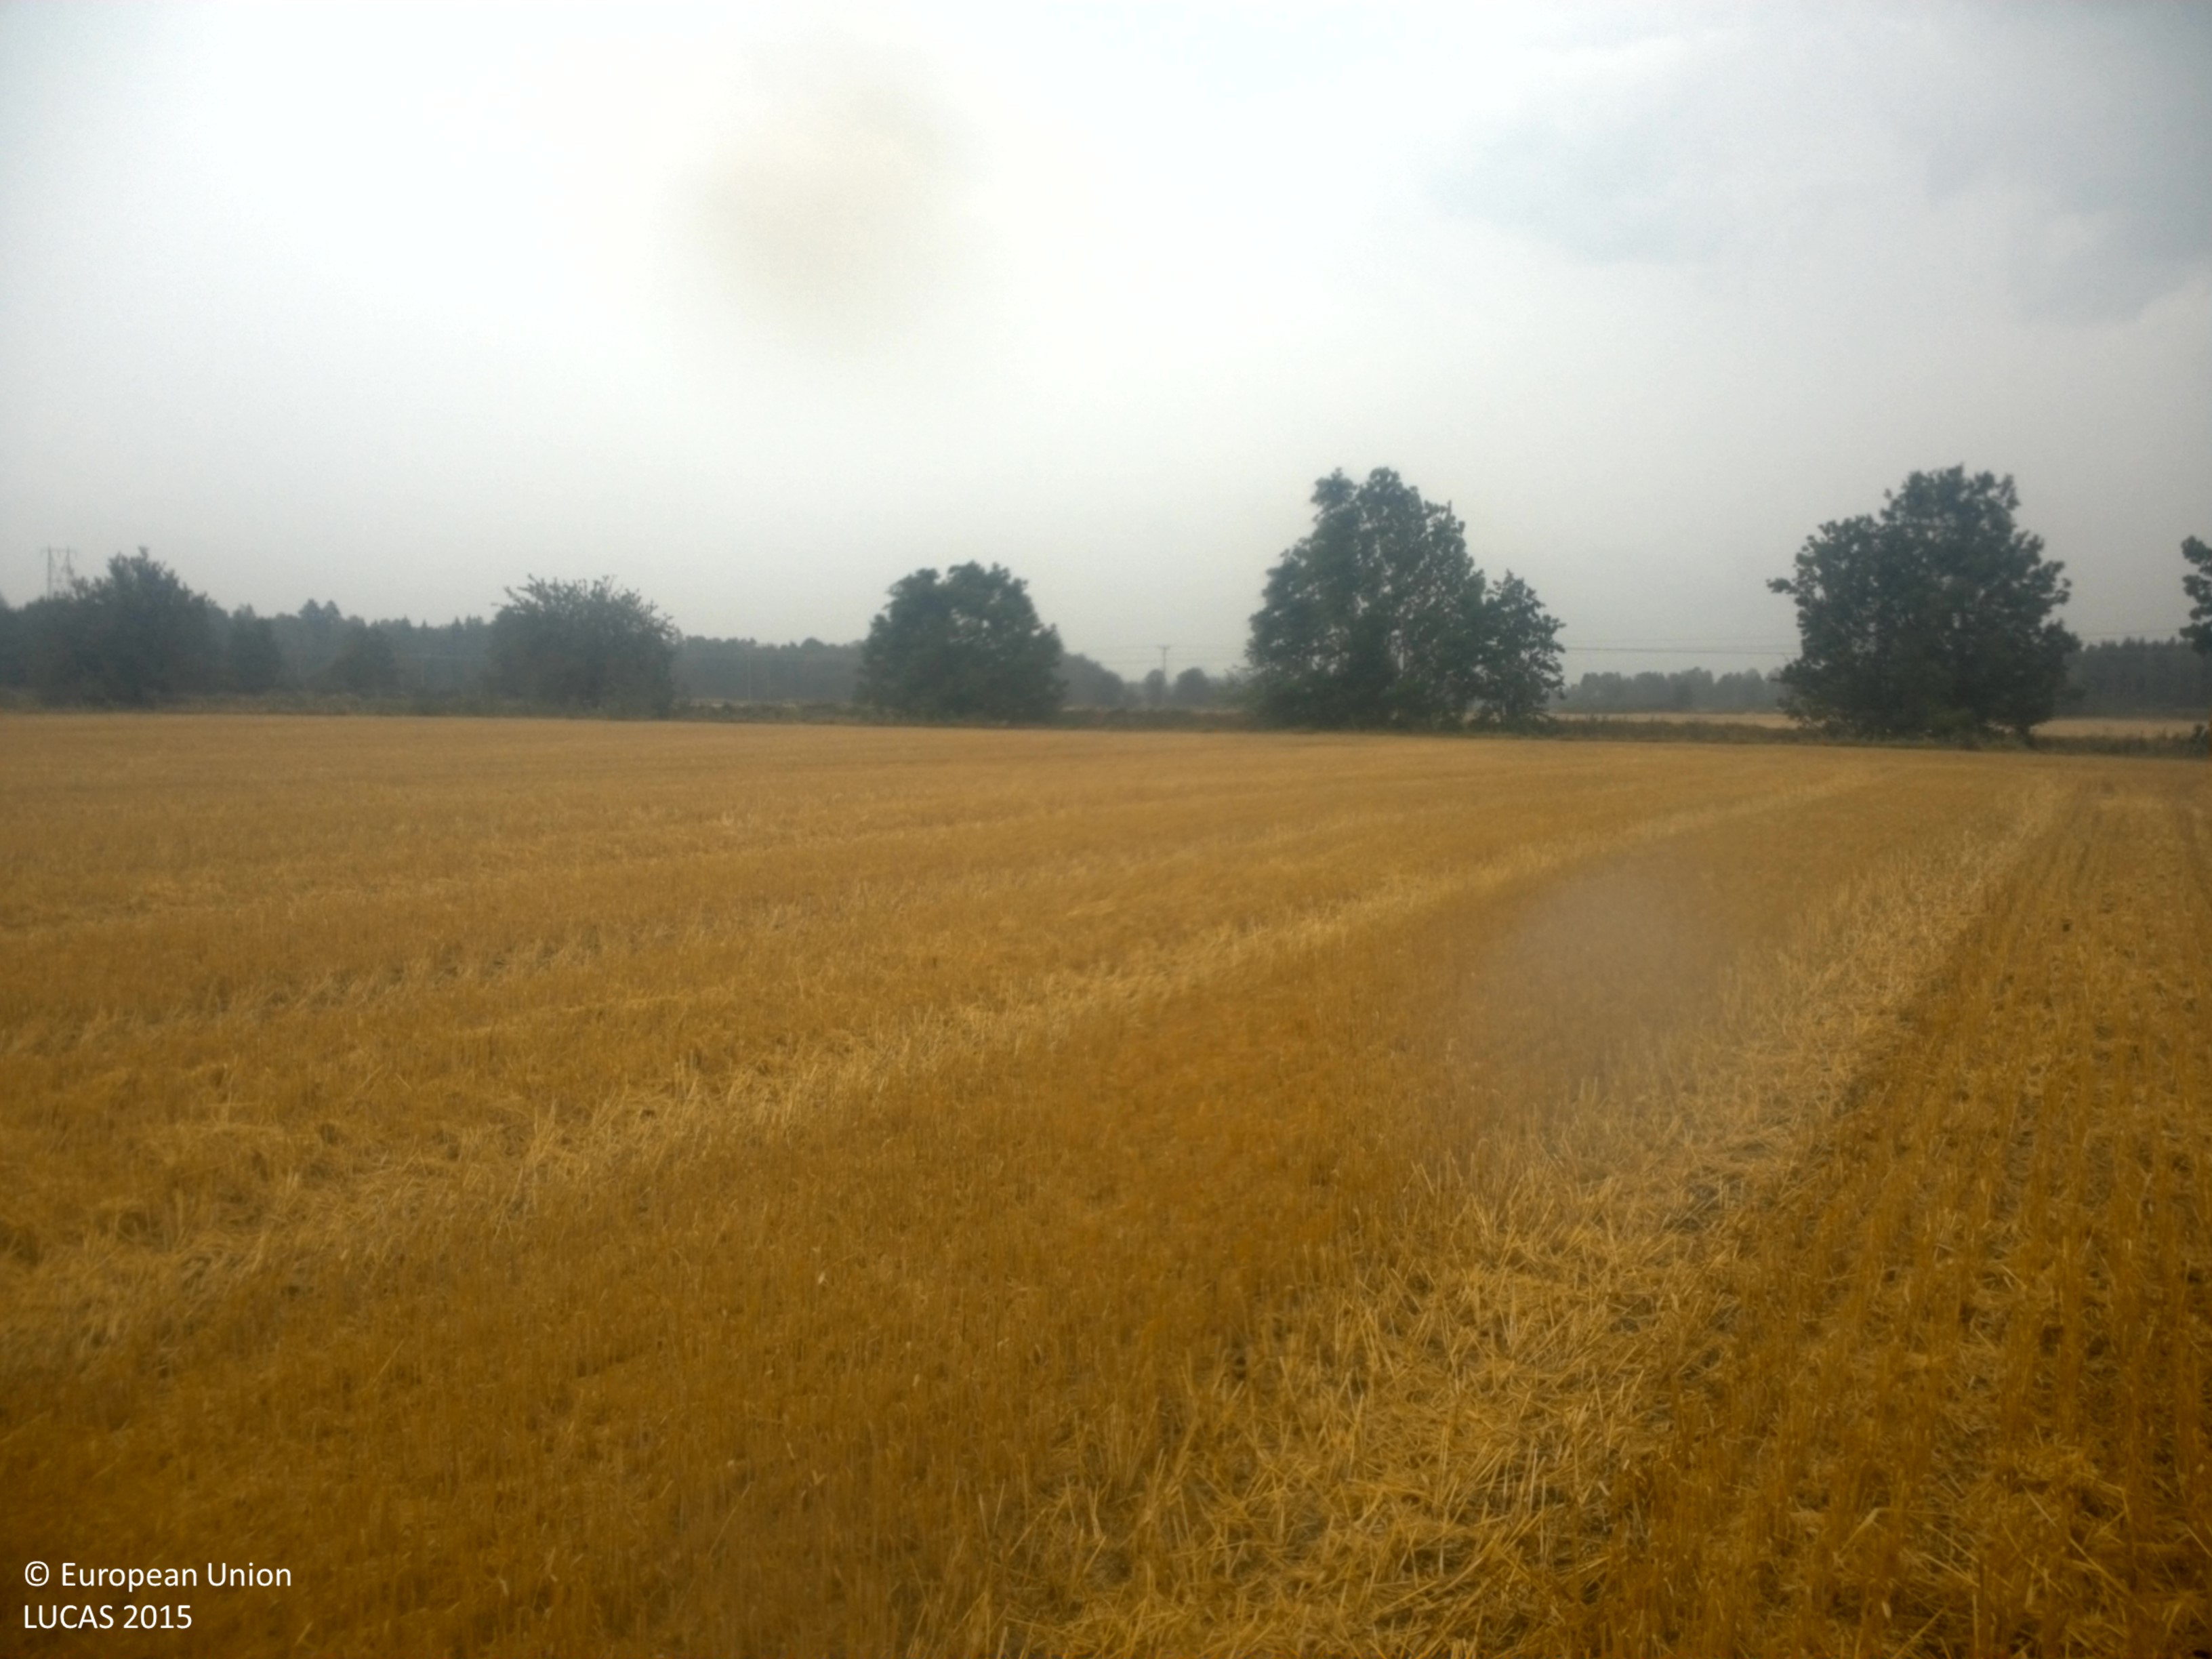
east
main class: Cropland
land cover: Oats
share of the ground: 50 - 75 %
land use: Agriculture (excluding fallow land and kitchen gardens)
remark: Harvested field
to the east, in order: Oats; Grassland with sparse tree/shrub cover; Rivers and streams; Broadleaved woodland; Grass margins; Oats; Electric lines; Oats
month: September
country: SE
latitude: 58.8077
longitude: 14.0263
